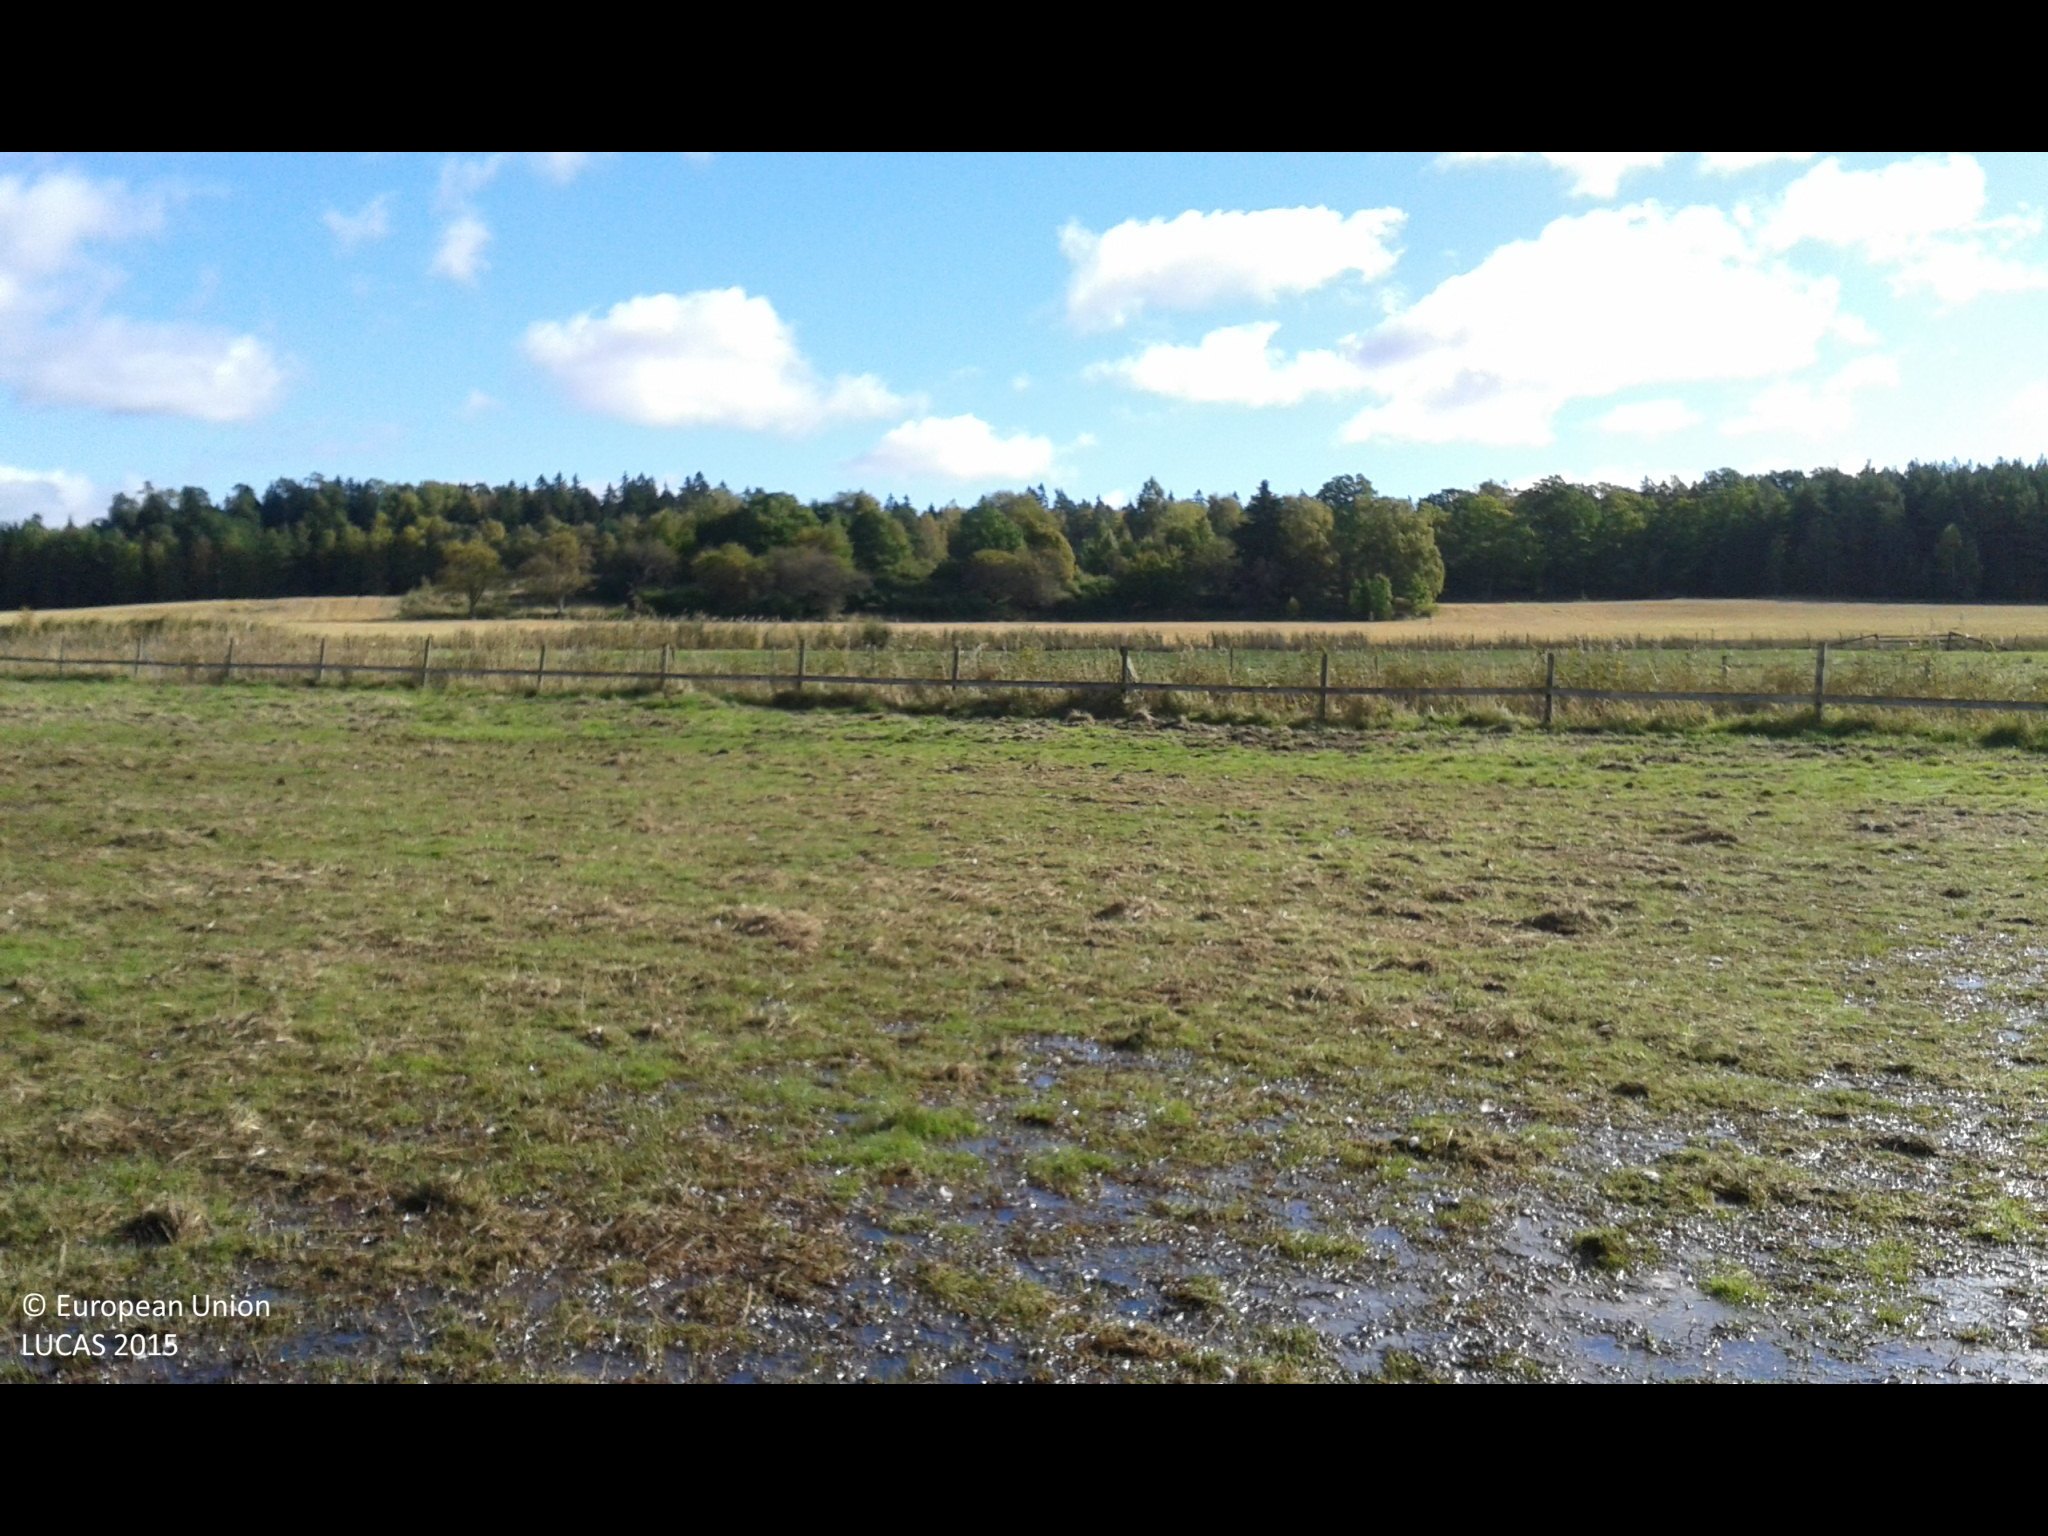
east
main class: Grassland
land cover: Grassland without tree/shrub cover
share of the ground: > 75 %
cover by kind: herbaceous plants 100 %
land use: Agriculture (excluding fallow land and kitchen gardens)
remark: Temporary flooded
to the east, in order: Grassland without tree/shrub cover; Fences; Ditches and canals; Fences; Grassland without tree/shrub cover; Fences; Ditches and canals; Other bare soil
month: September
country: SE
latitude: 58.9628
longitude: 17.5969
